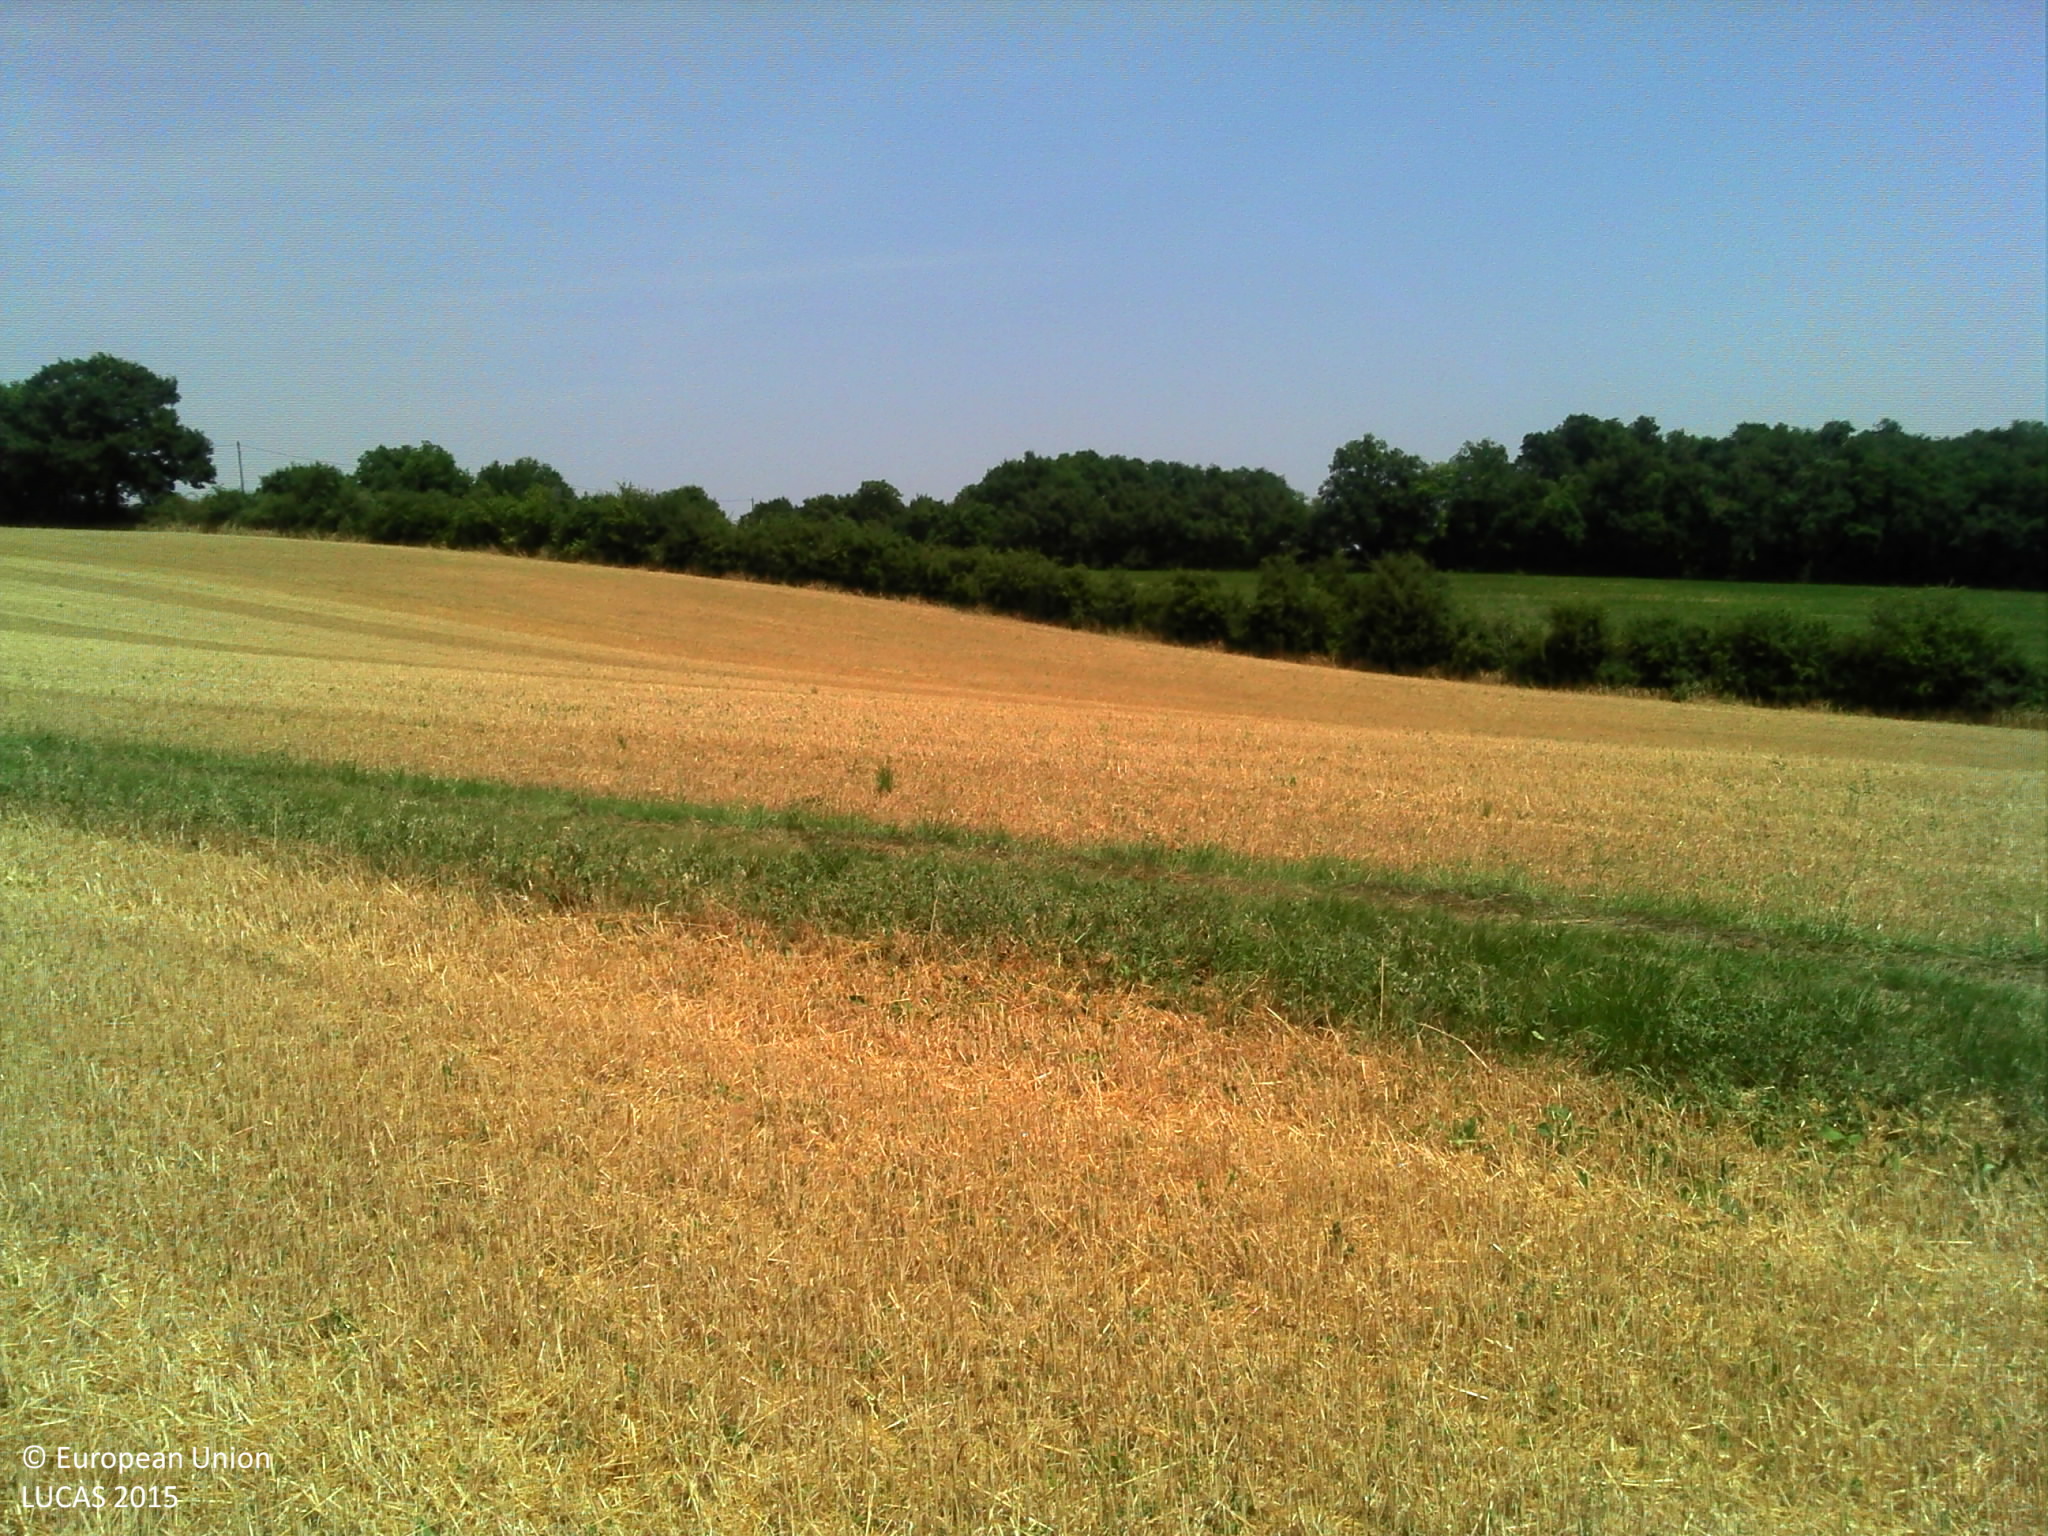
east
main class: Cropland
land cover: Barley
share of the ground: > 75 %
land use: Agriculture (excluding fallow land and kitchen gardens)
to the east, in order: Barley; Tracks; Grass margins; Barley; Abandoned hedges; Soya
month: July
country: FR
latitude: 43.6492
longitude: 0.9866
